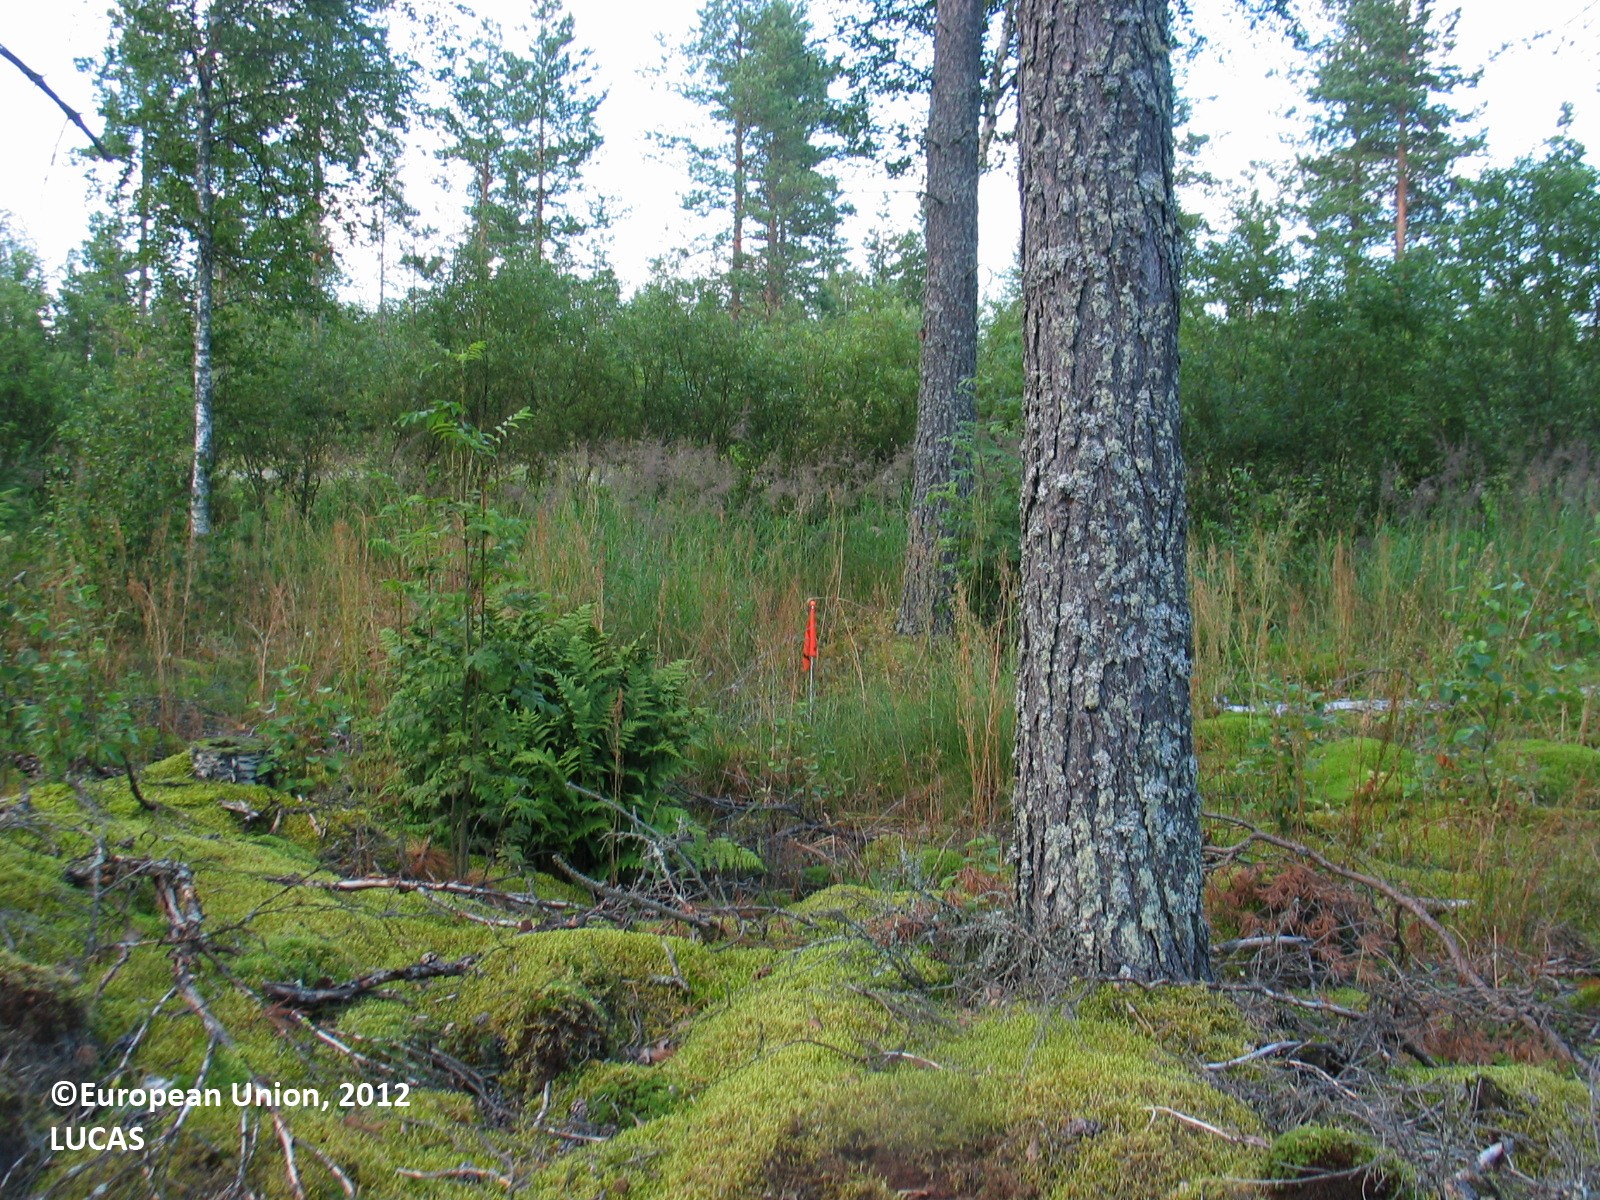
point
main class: Woodland
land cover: Other mixed woodland
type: boreal forest
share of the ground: 25 - 50 %
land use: Forestry
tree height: > 5 m
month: July
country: FI
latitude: 64.7034
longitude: 26.4067
